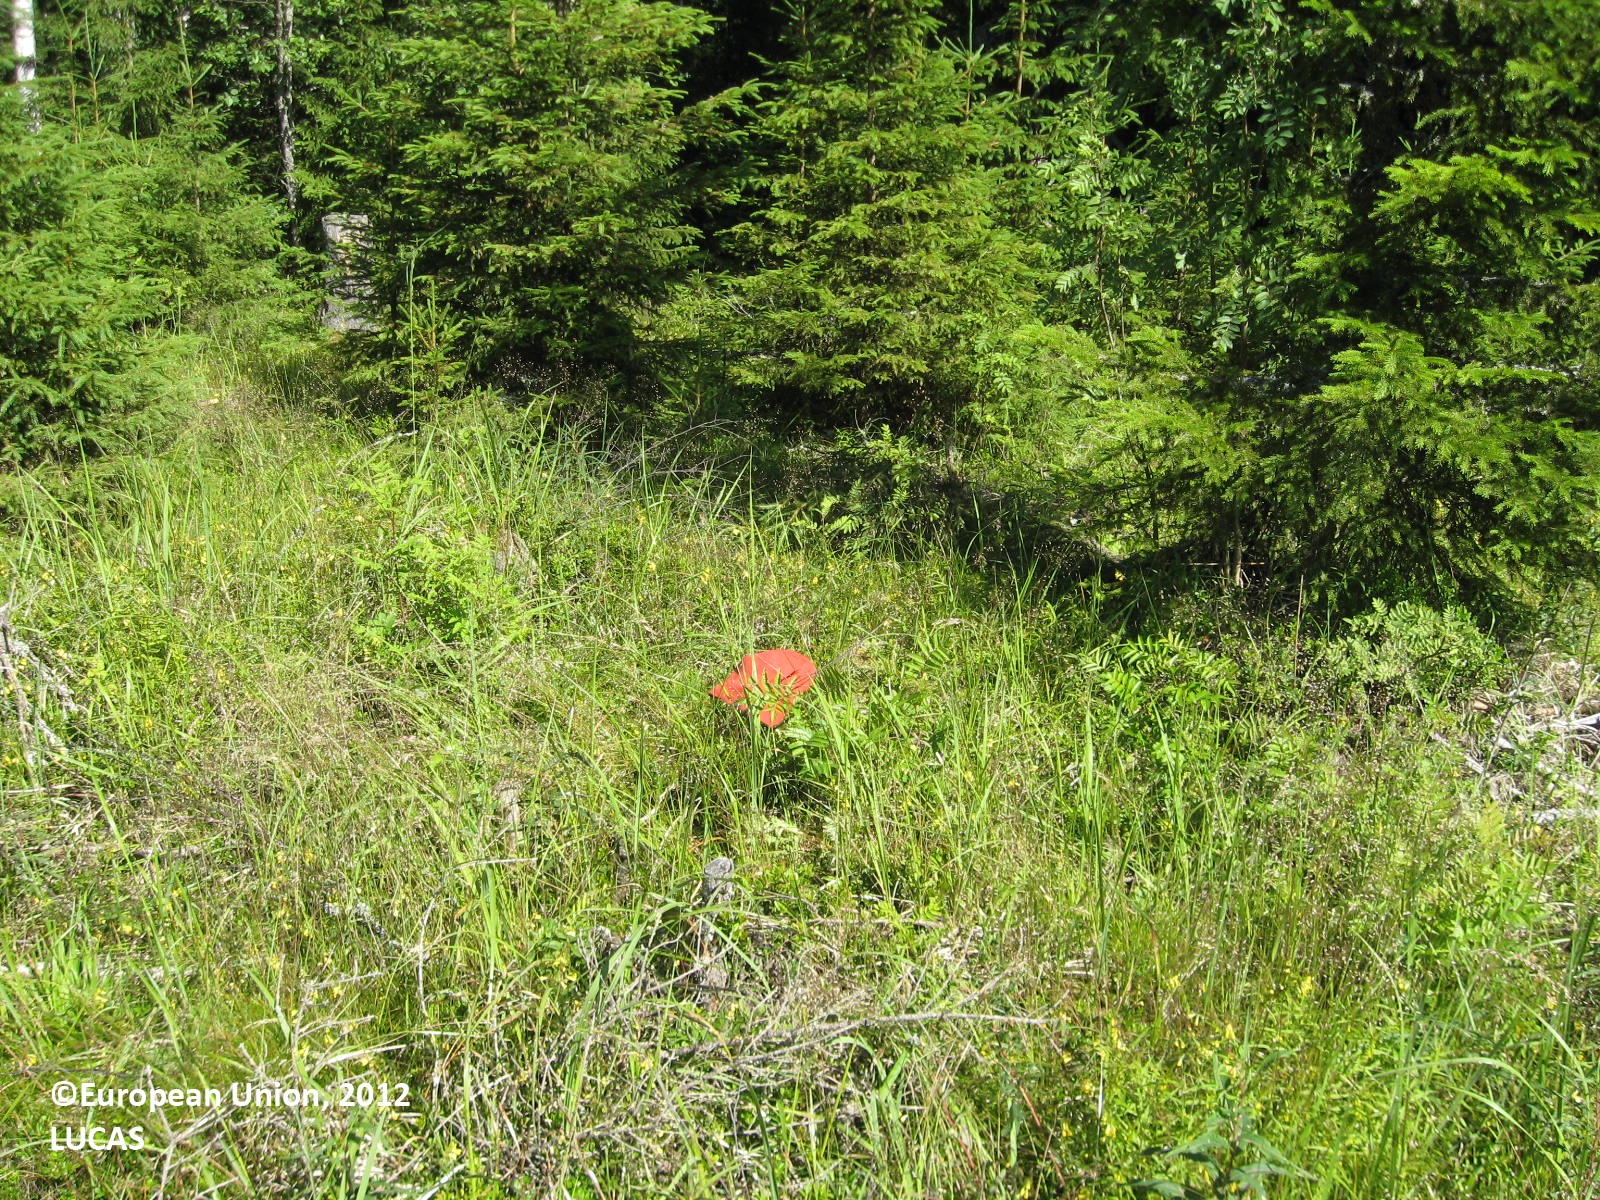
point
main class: Woodland
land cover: Spruce dominated mixed woodland
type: boreal forest
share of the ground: 50 - 75 %
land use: Energy production
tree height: > 5 m
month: July
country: FI
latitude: 62.1578
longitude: 21.6595
